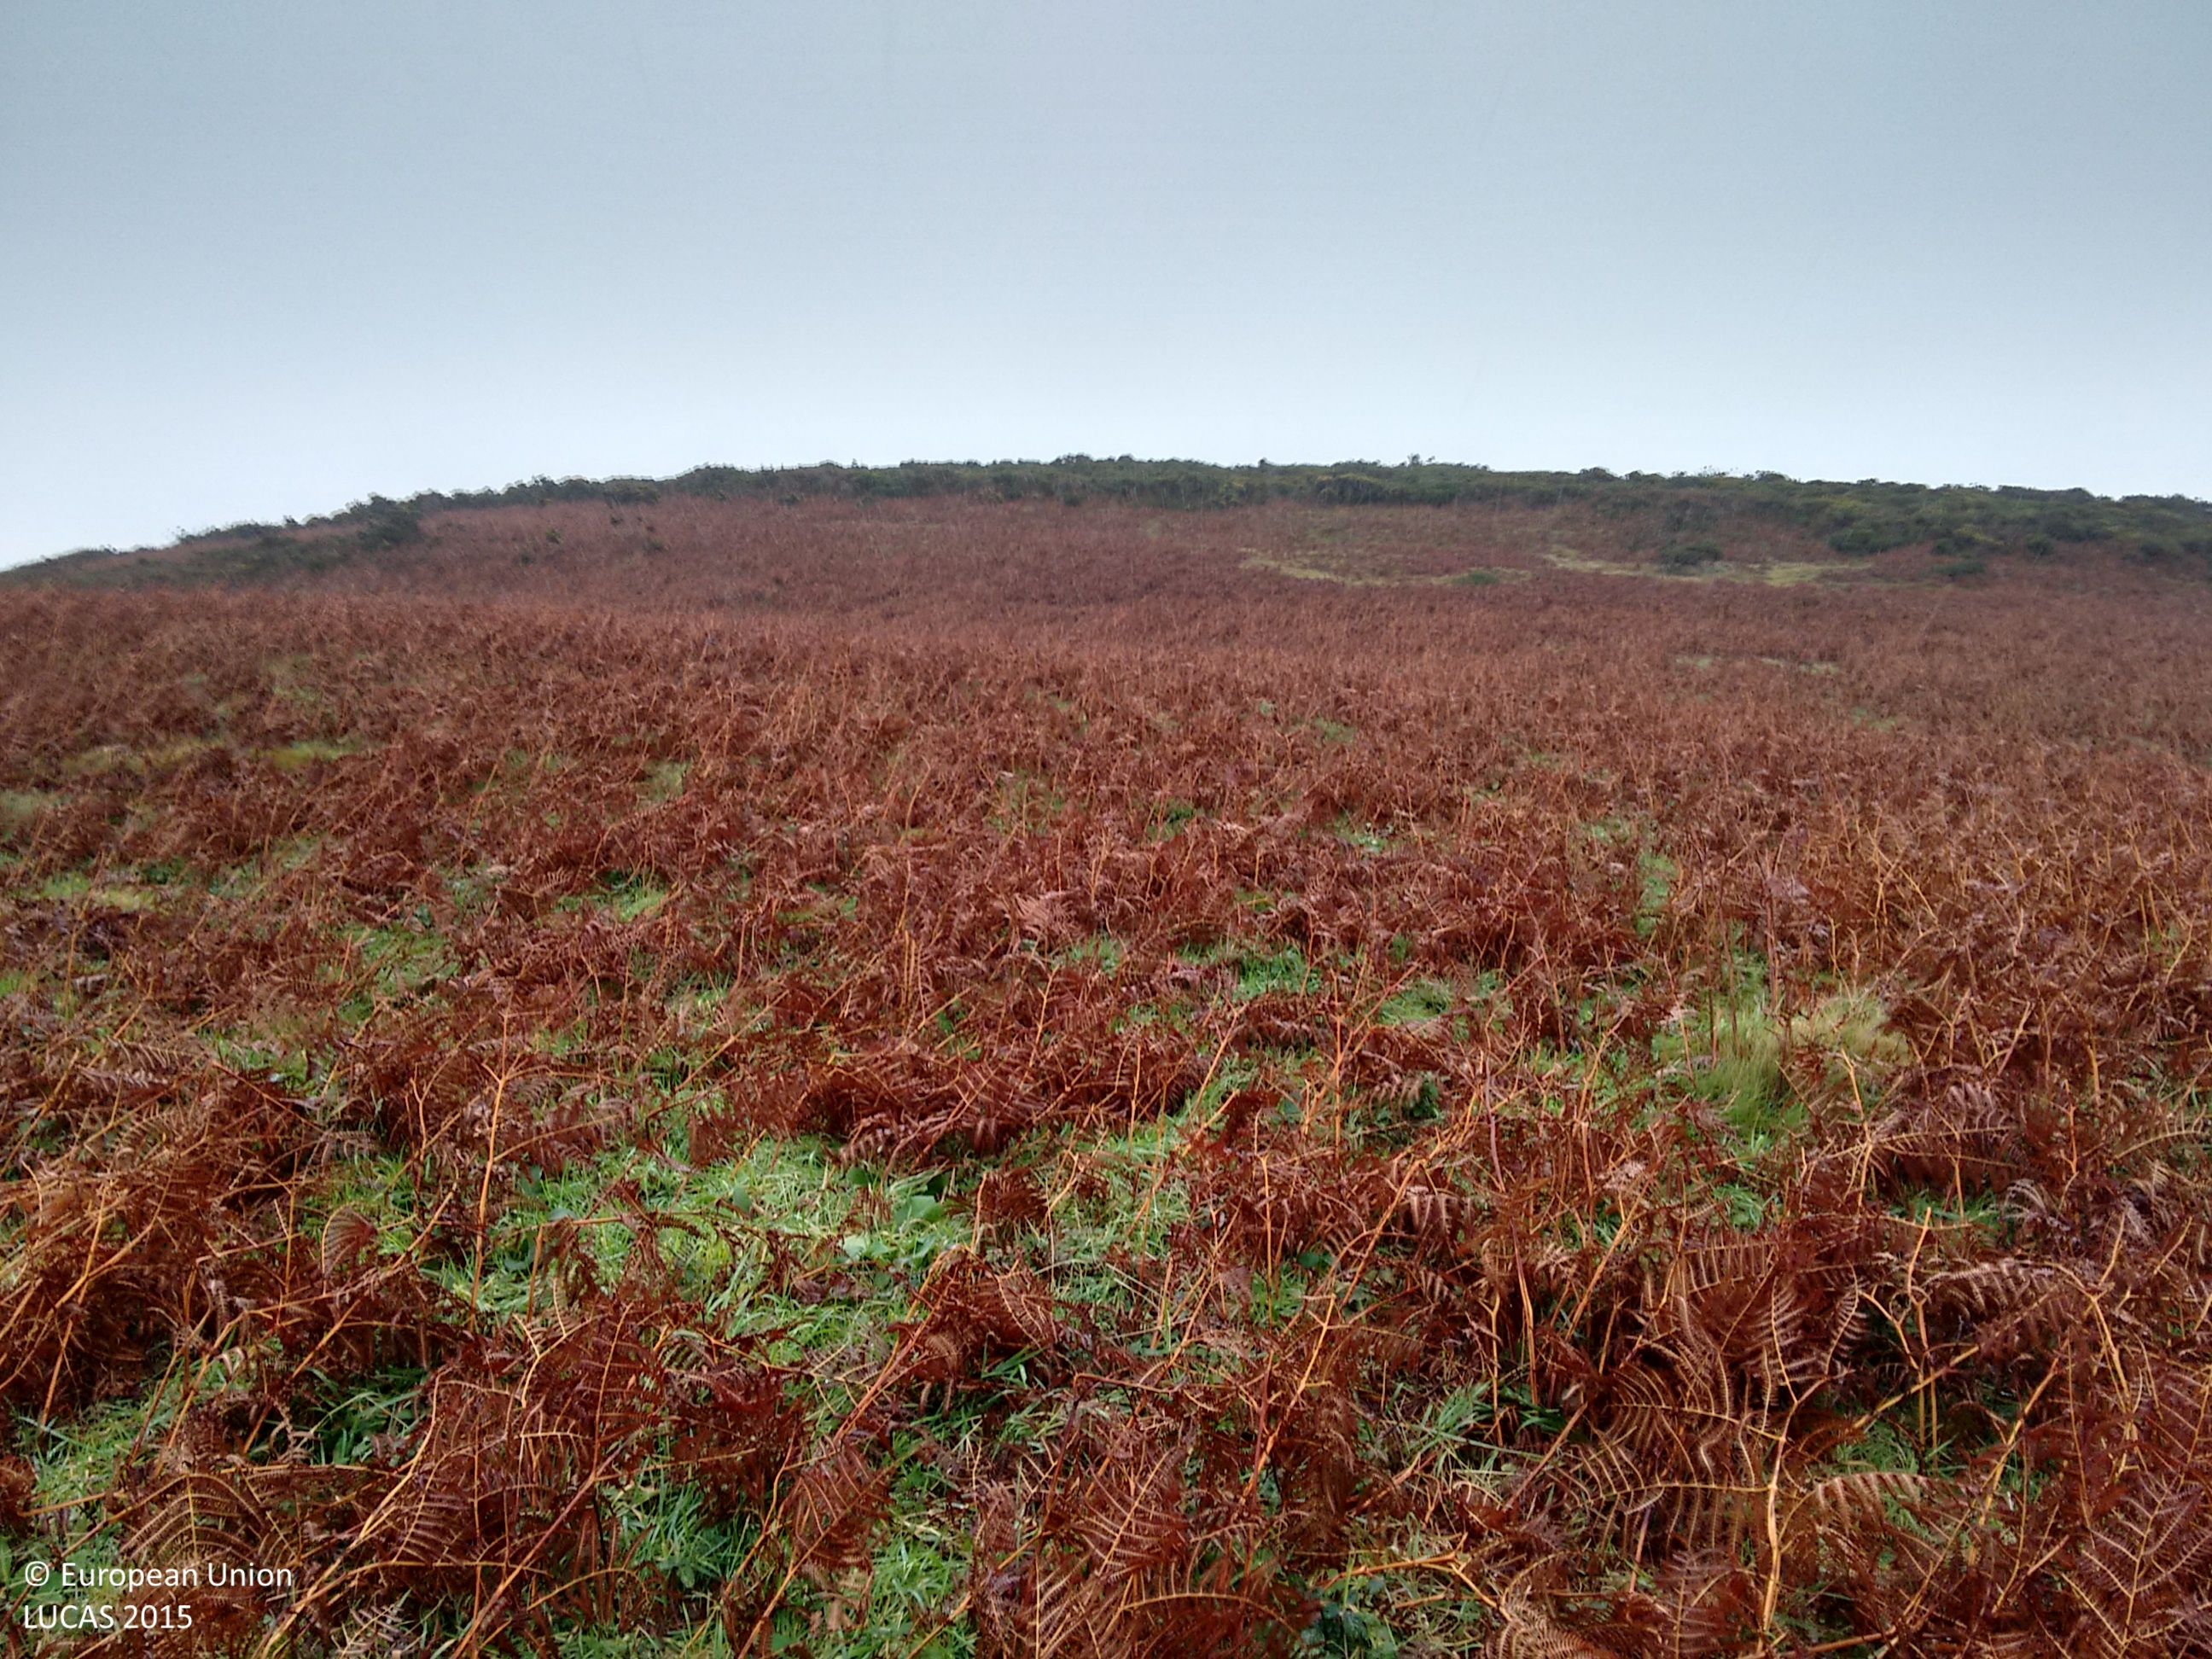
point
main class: Shrubland
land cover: Shrubland without tree cover
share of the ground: > 75 %
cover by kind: shrubs 80 %, herbaceous plants 20 %
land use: Agriculture (excluding fallow land and kitchen gardens)
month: November
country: GB
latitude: 52.7962
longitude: -4.5061
